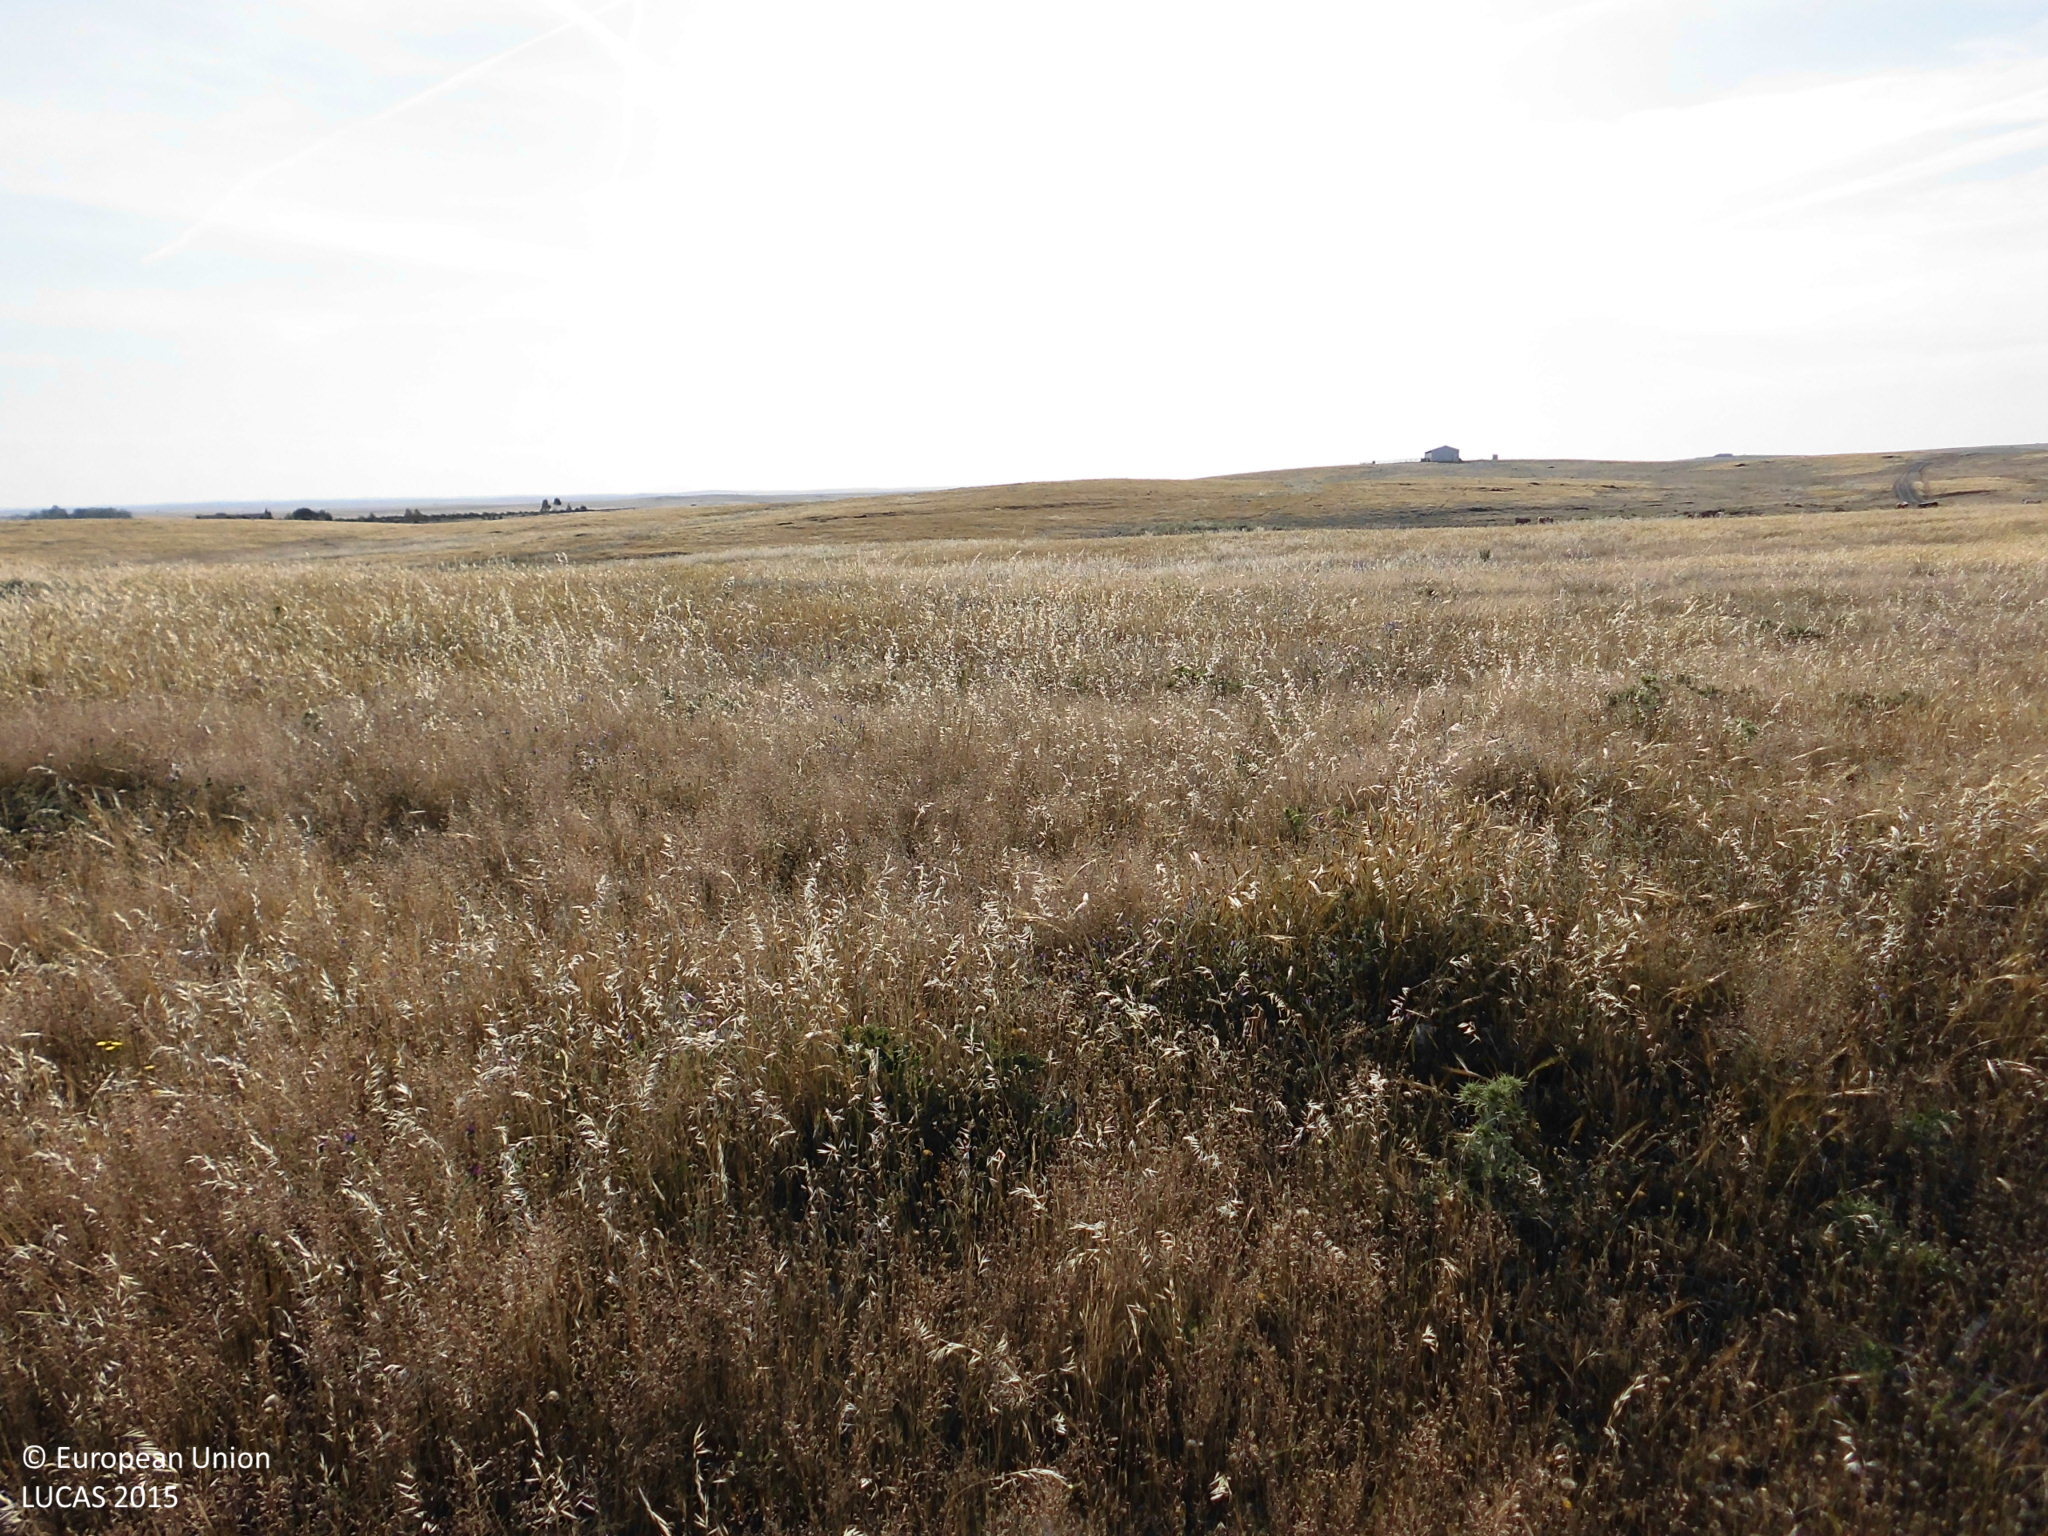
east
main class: Grassland
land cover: Grassland without tree/shrub cover
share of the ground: > 75 %
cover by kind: herbaceous plants 100 %
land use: Agriculture (excluding fallow land and kitchen gardens)
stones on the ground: 10 - 25 %
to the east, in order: Grassland without tree/shrub cover; Inland fresh water bodies; Spontaneously vegetated surfaces; Grassland without tree/shrub cover
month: May
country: ES
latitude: 39.6301
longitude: -6.9413
